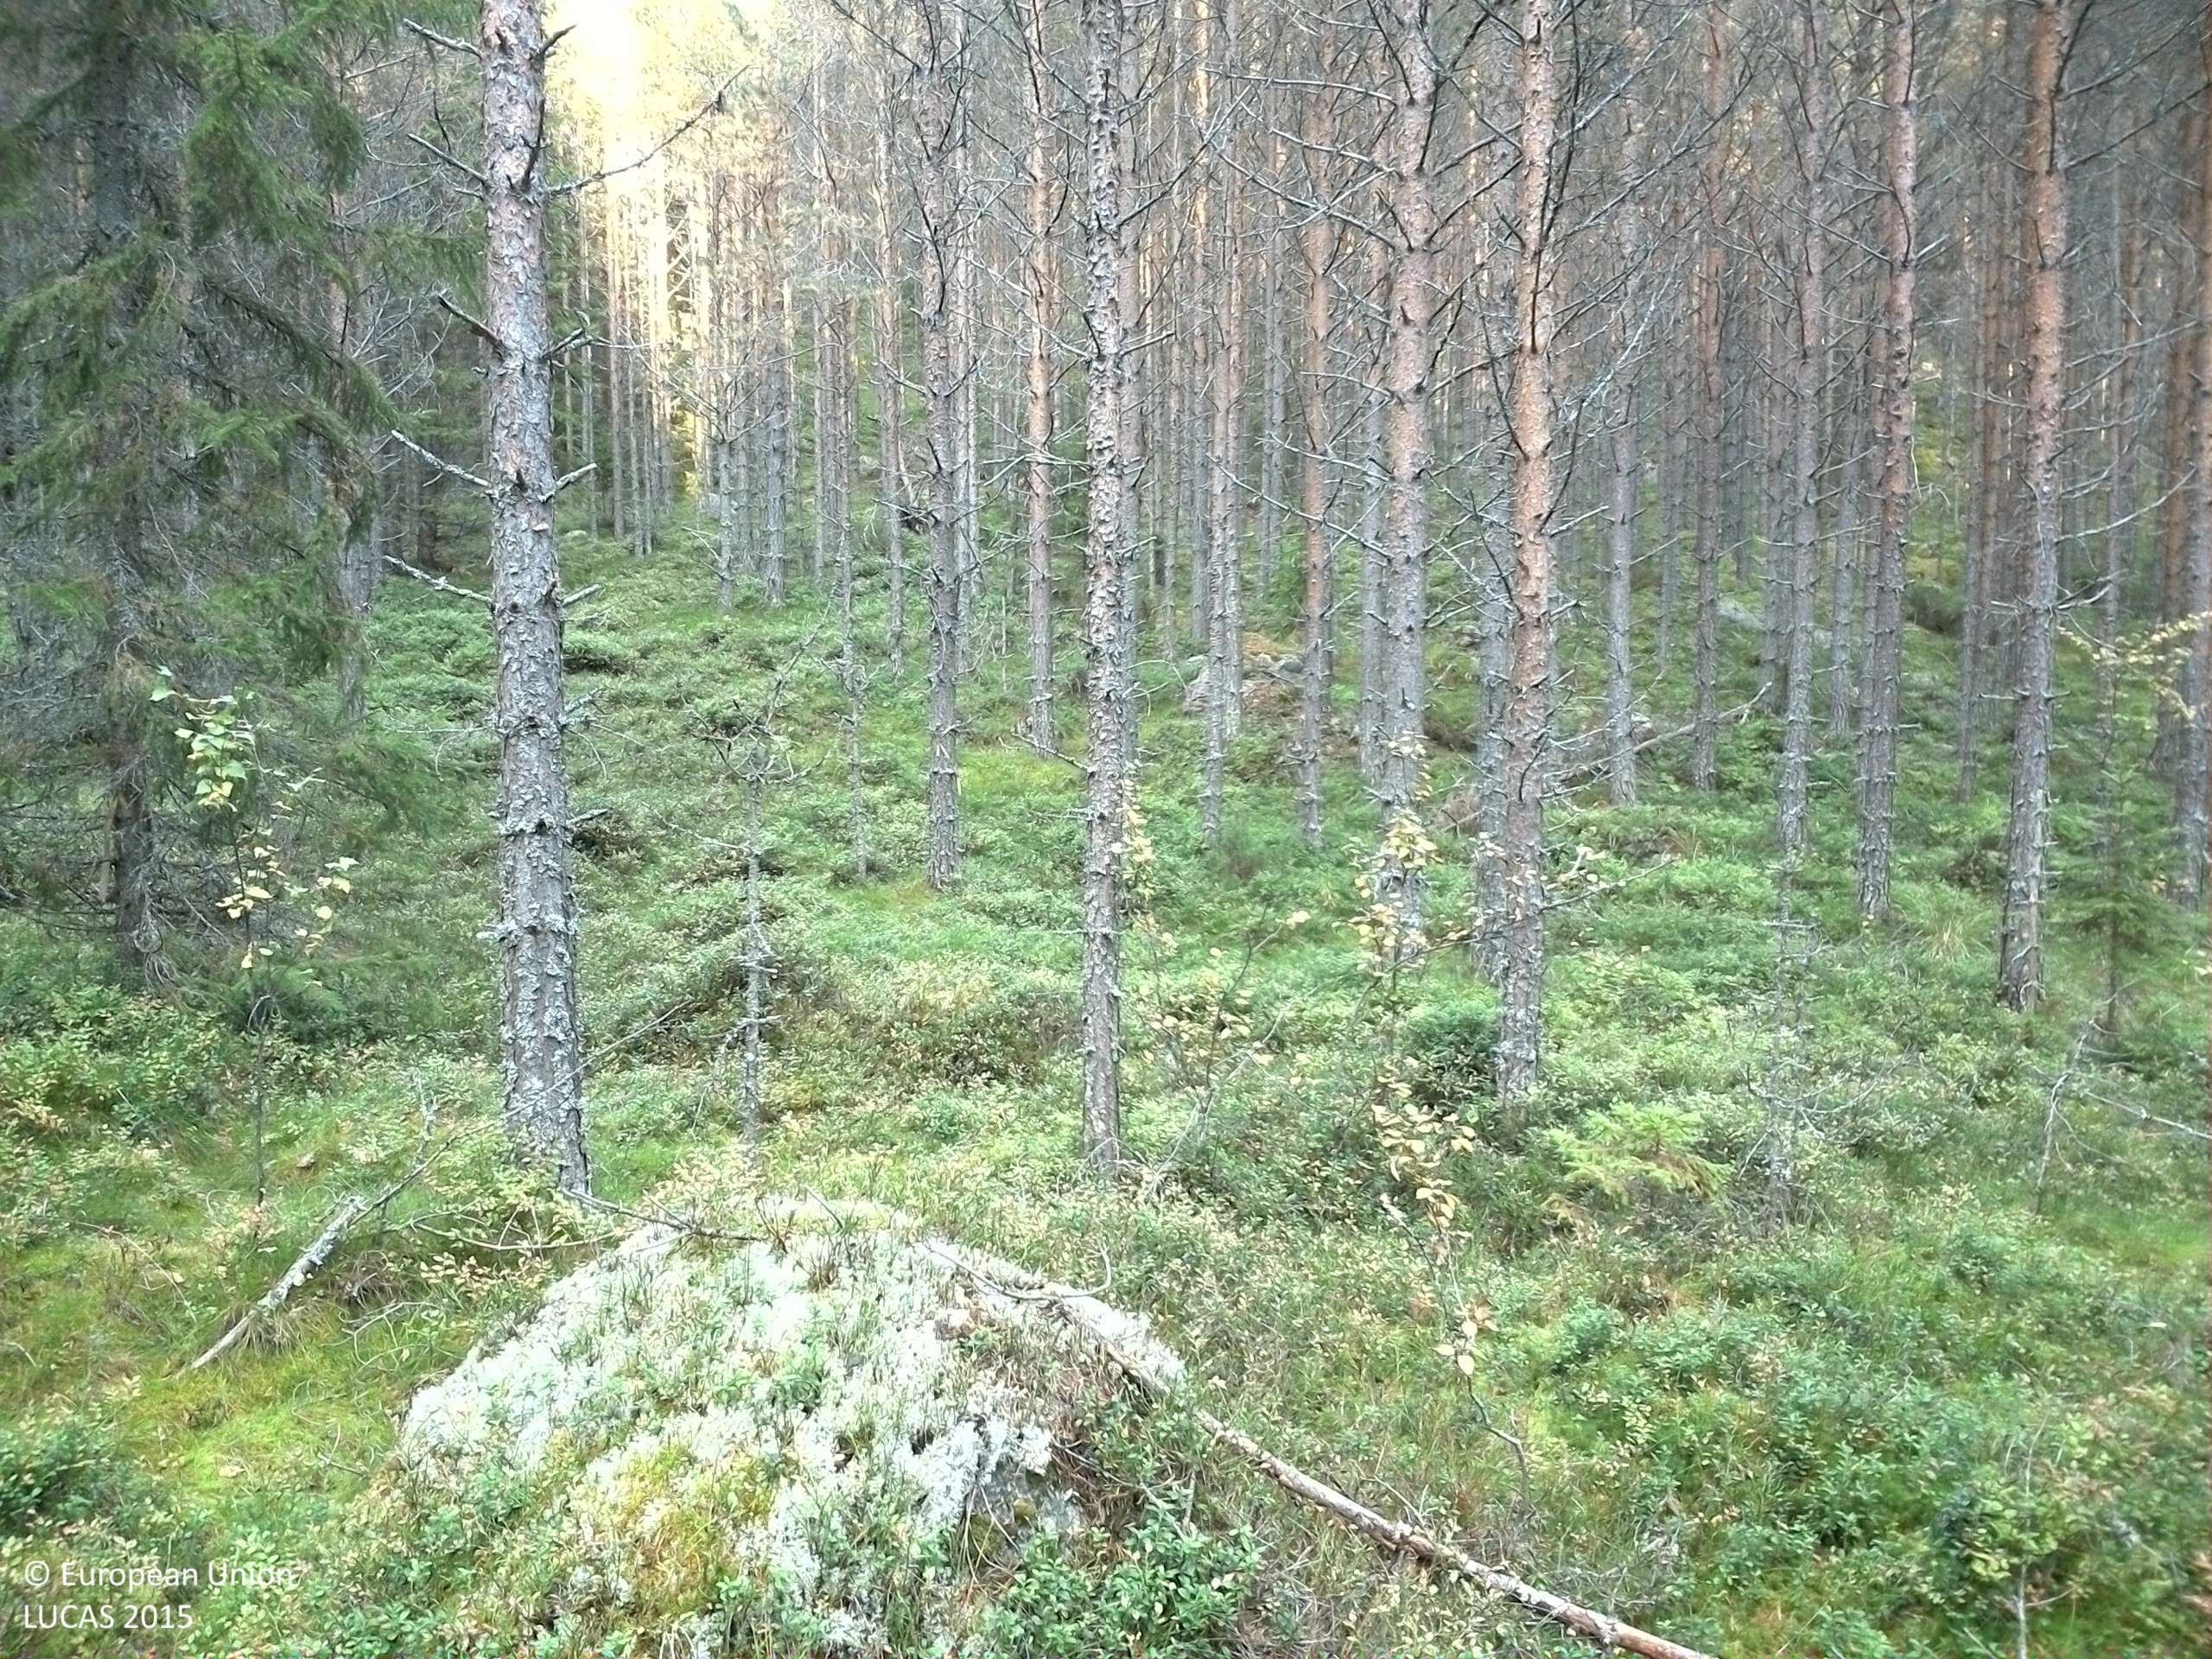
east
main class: Woodland
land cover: Pine dominated coniferous woodland
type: boreal forest
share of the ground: 50 - 75 %
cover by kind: coniferous forest trees 60 %, shrubs 25 %, lichens and mosses 15 %
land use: Forestry
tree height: > 5 m
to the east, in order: Pine dominated coniferous woodland
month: September
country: SE
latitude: 61.3030
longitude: 15.4547
